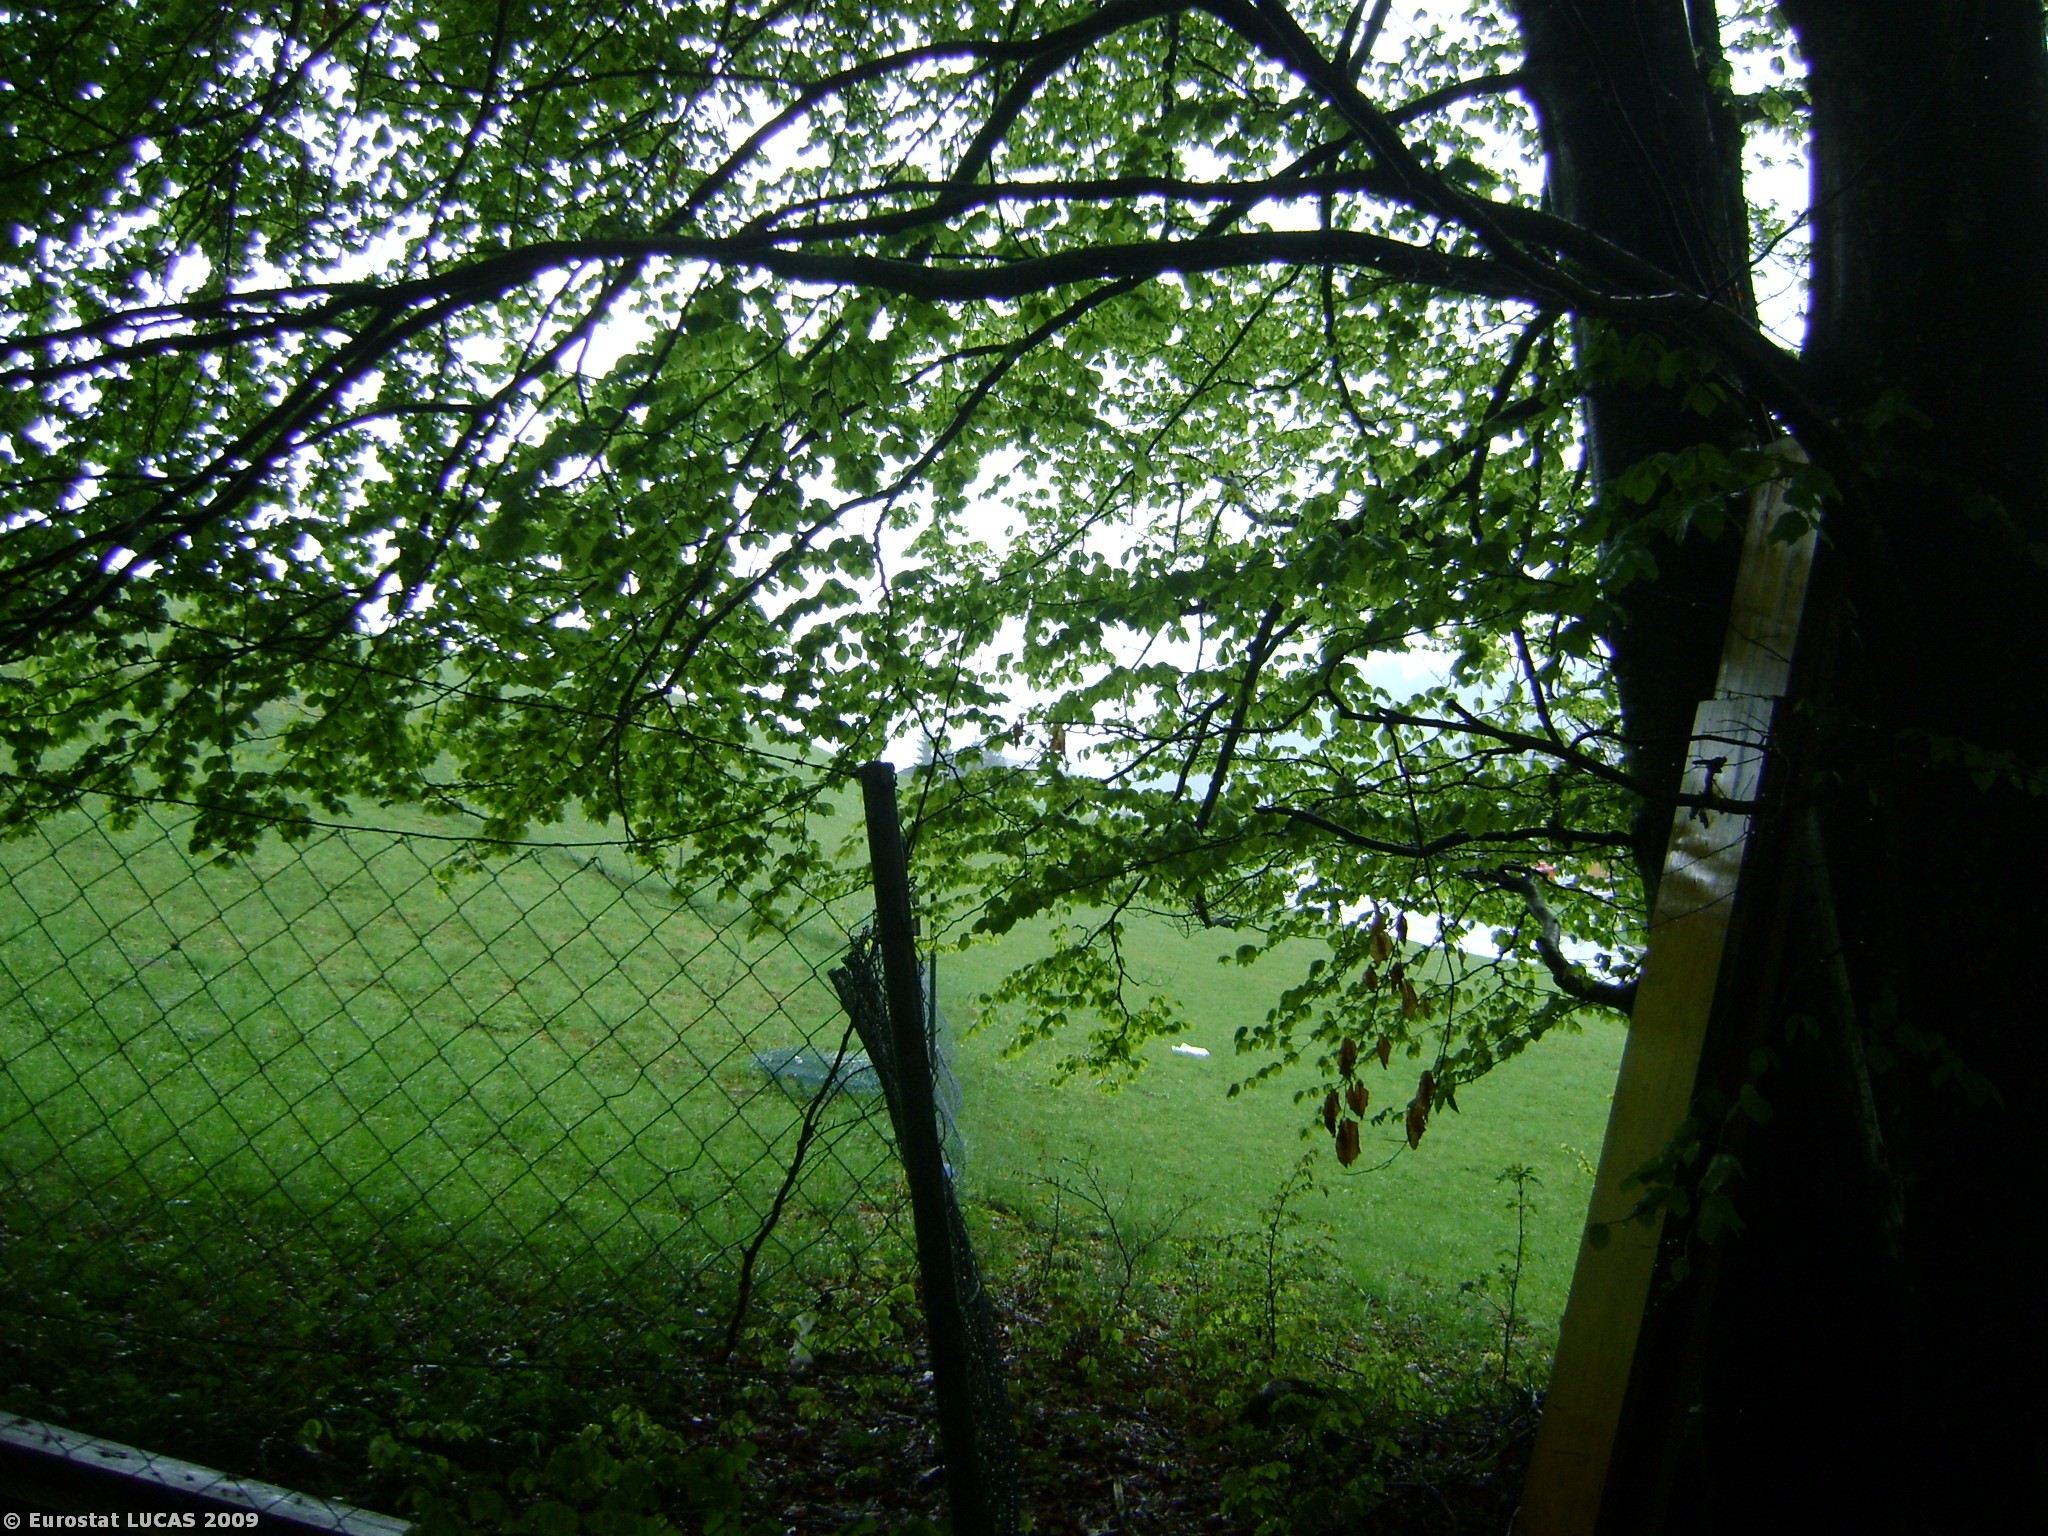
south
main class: Woodland
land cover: Mixed woodland
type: hemiboreal forest and nemoral coniferous forest and mixed broadleaved-coniferous forest
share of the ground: > 75 %
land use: Forestry
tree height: > 5 m
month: May
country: AT
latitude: 47.7797
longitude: 13.2417
